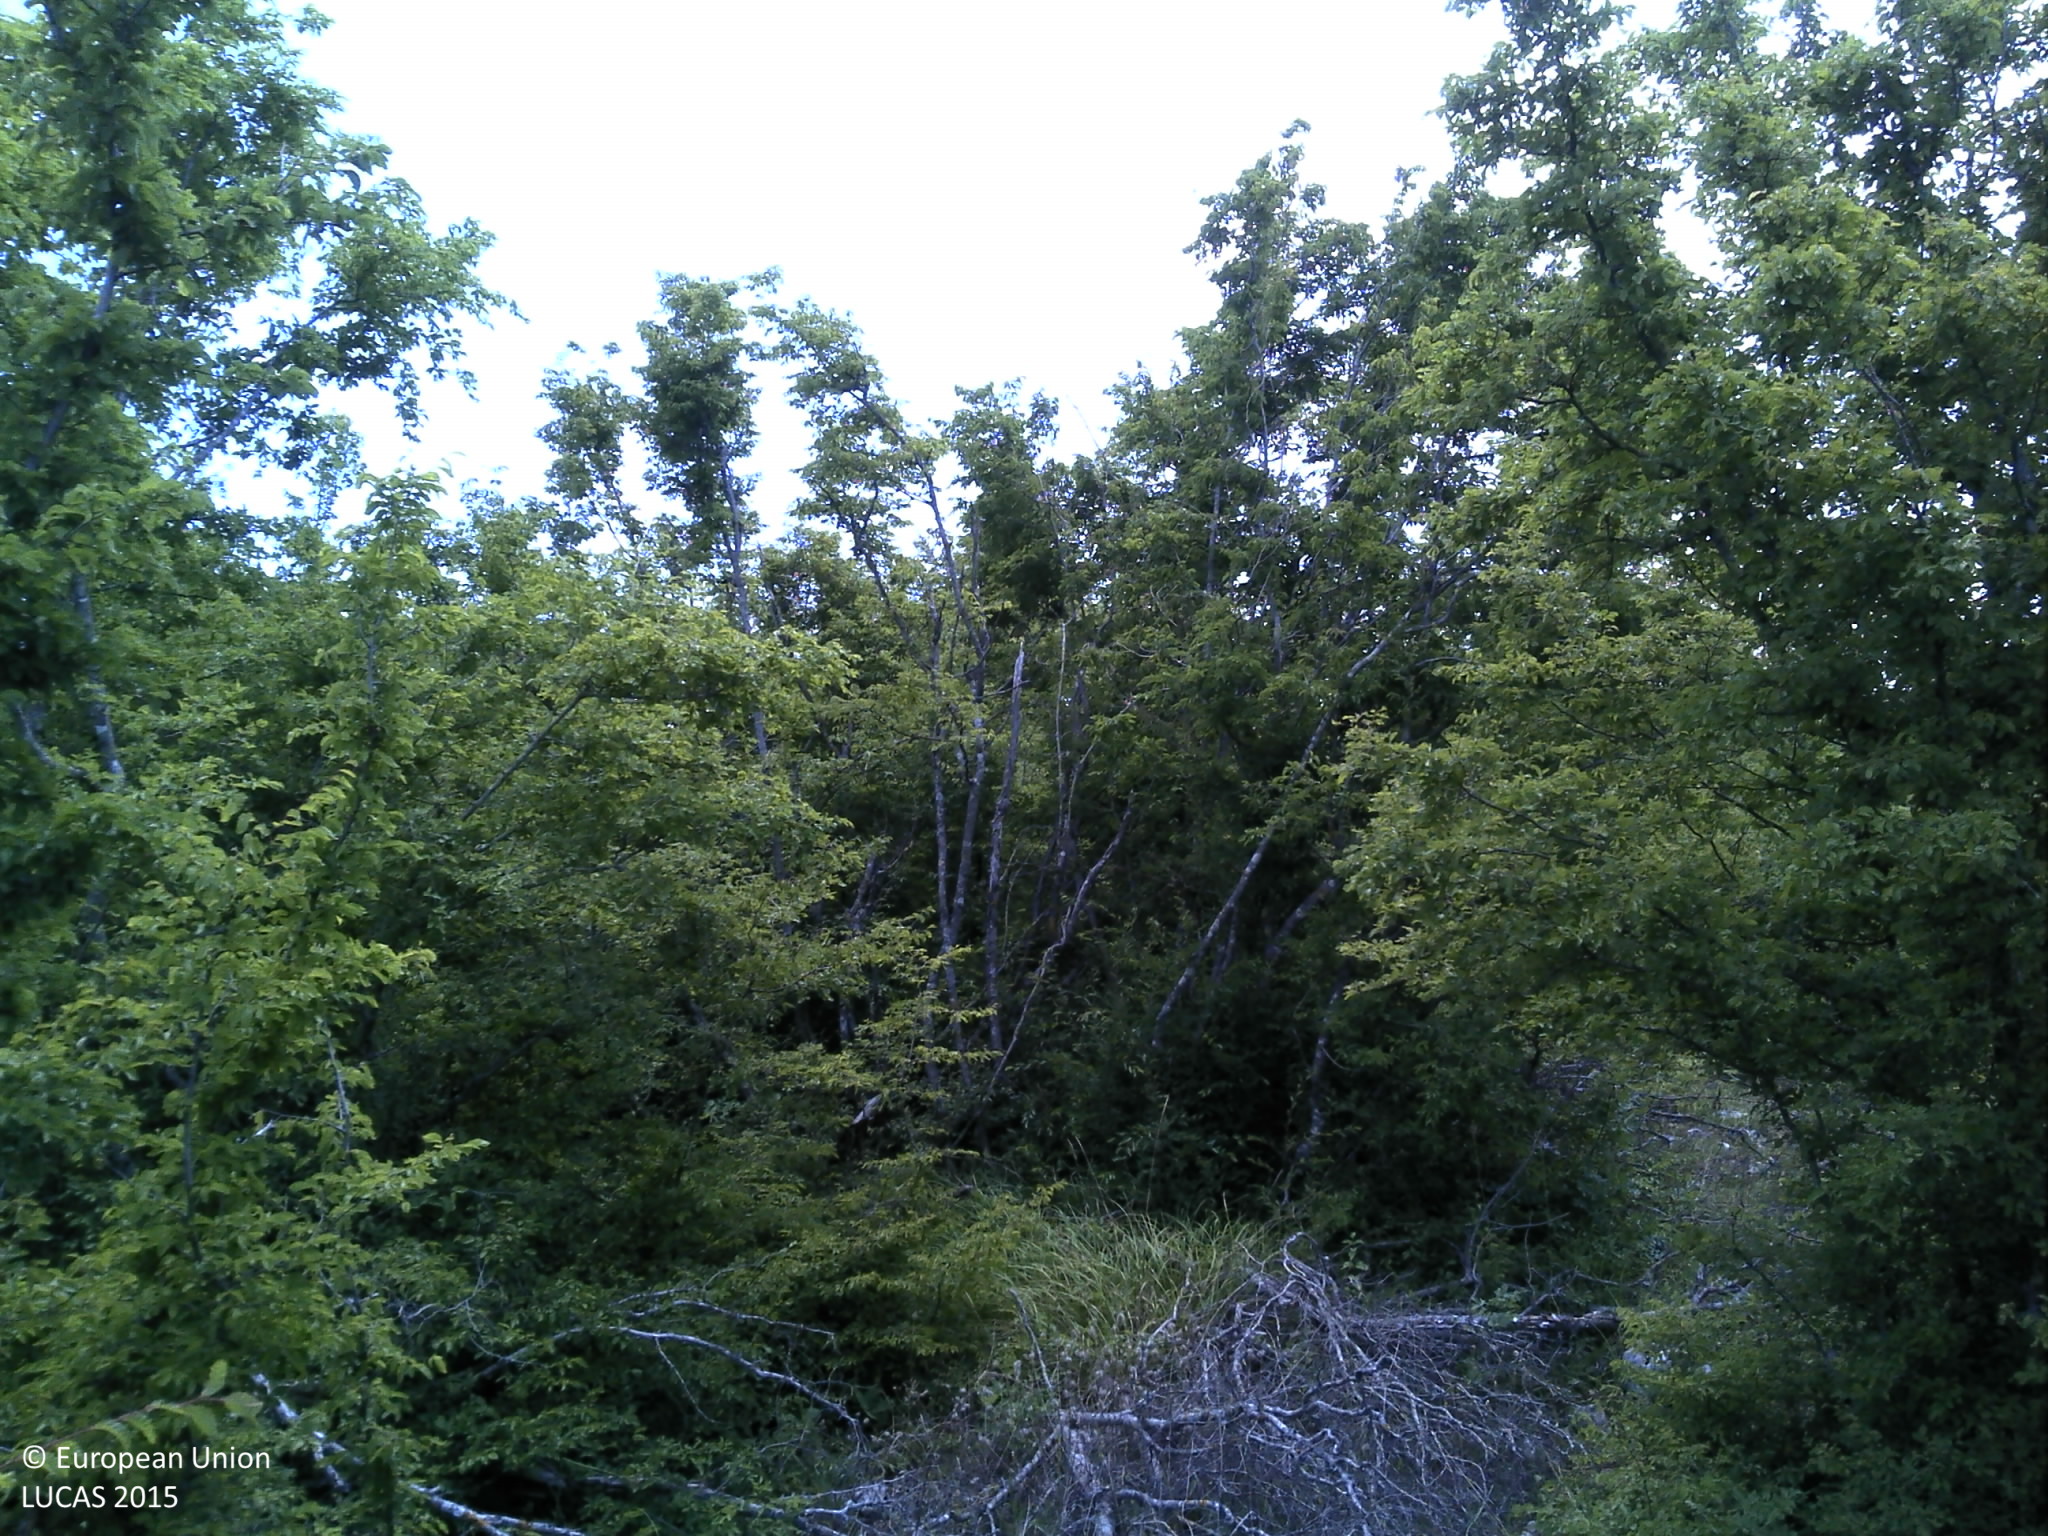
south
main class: Woodland
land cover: Broadleaved woodland
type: thermophilous deciduous forest
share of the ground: 25 - 50 %
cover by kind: shrubs 40 %, broadleaved forest trees 35 %, unconsolidated bare surface 15 %, coniferous forest trees 10 %
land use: Semi-natural and natural areas not in use
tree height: > 5 m
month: June
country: HR
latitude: 44.0671
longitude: 16.0226
